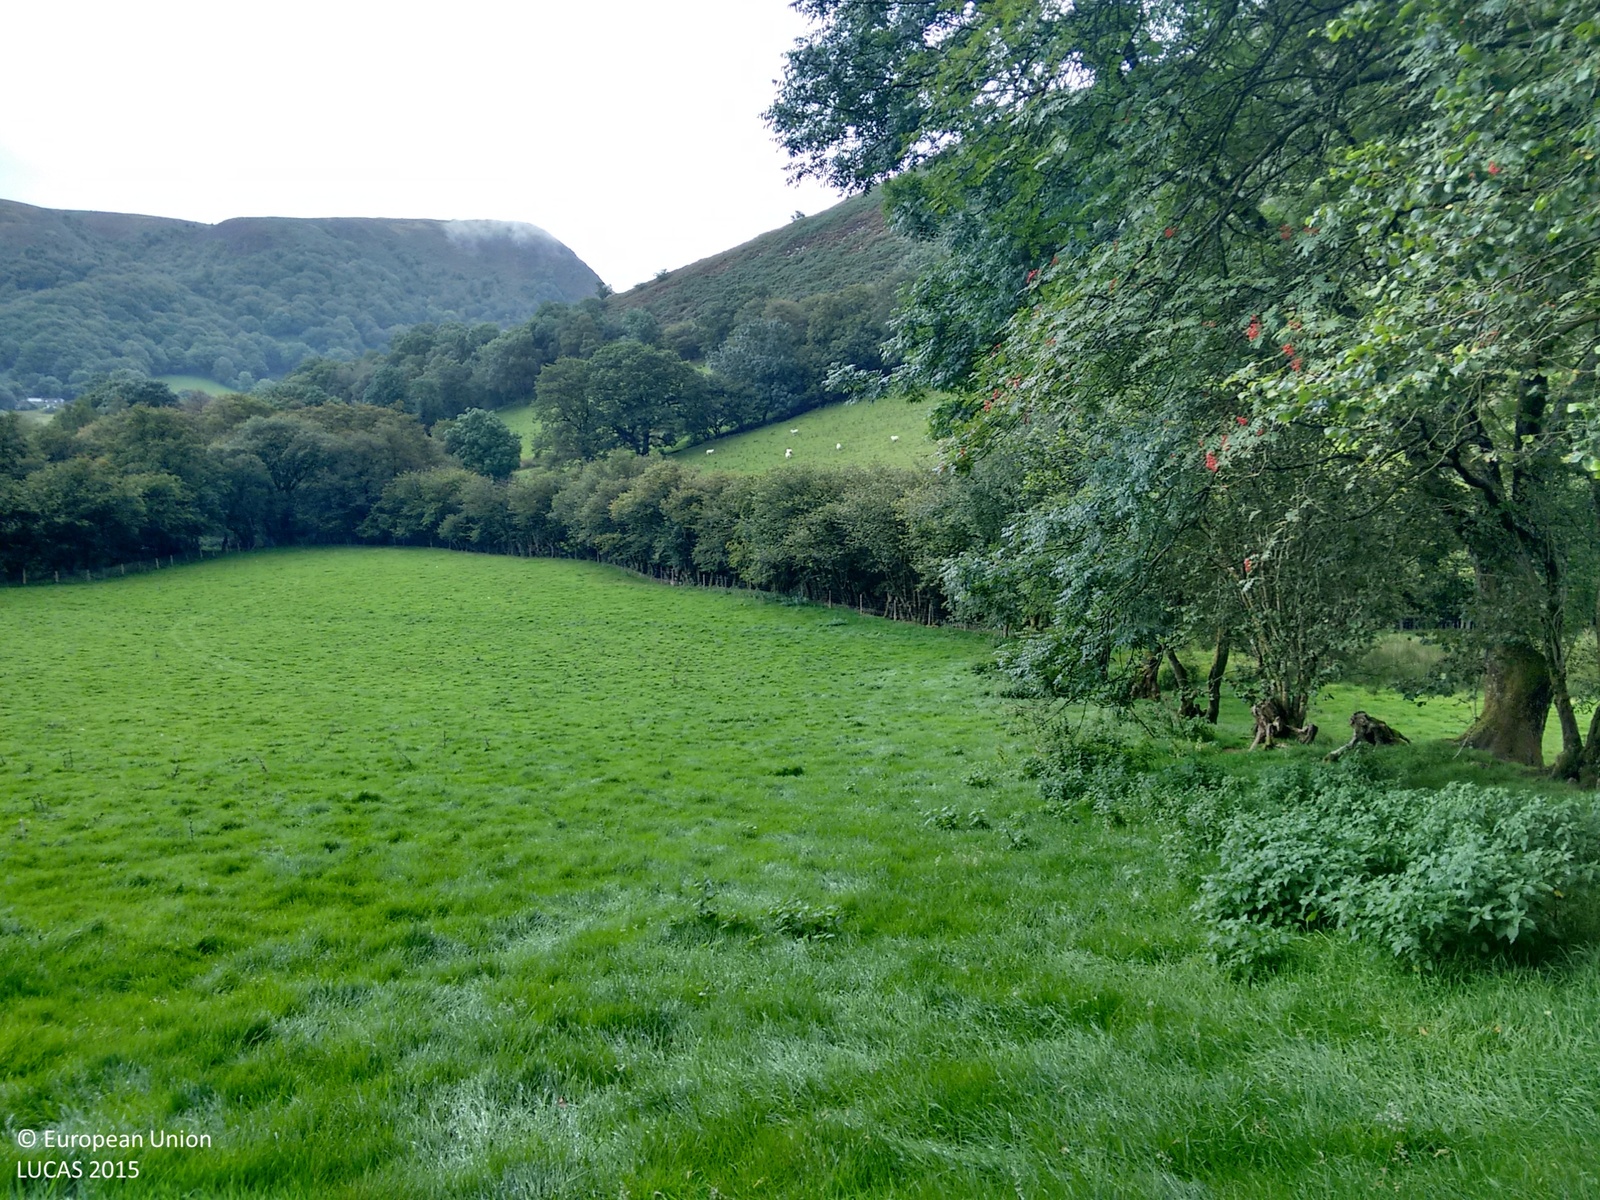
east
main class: Grassland
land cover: Grassland without tree/shrub cover
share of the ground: > 75 %
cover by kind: herbaceous plants 100 %
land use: Agriculture (excluding fallow land and kitchen gardens)
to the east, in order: Grassland without tree/shrub cover; Fences; Abandoned hedges; Rivers and streams; Abandoned hedges; Grassland without tree/shrub cover; Fences; Broadleaved woodland; Grassland with sparse tree/shrub cover
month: September
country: GB
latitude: 52.0926
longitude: -3.8258
